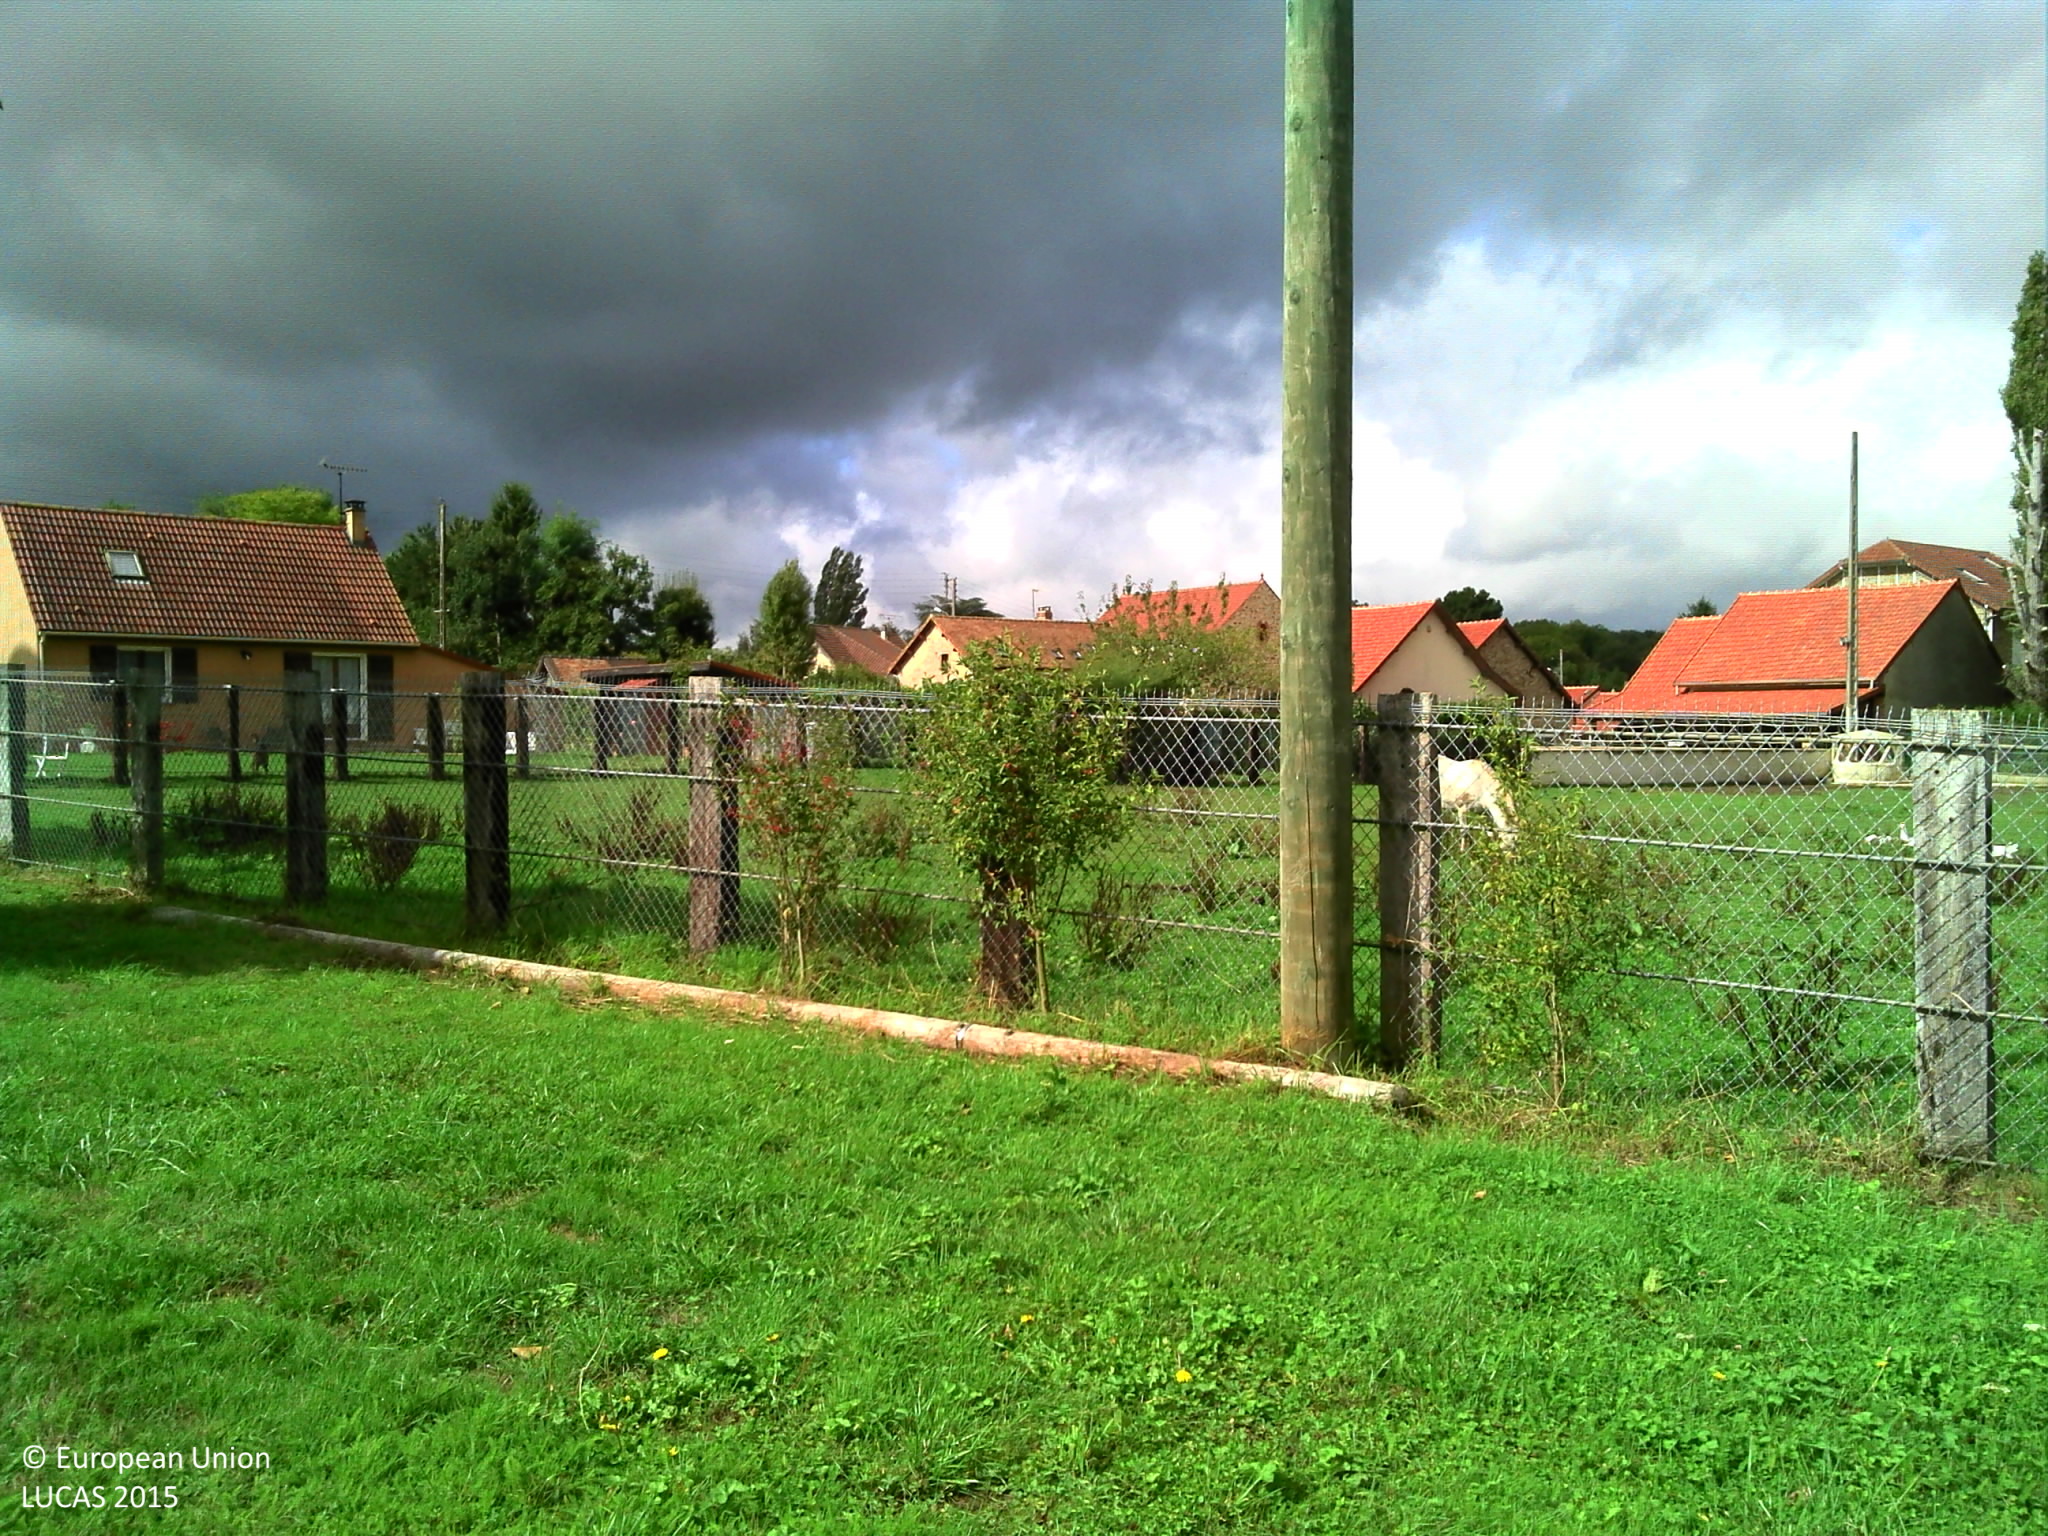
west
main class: Grassland
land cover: Grassland without tree/shrub cover
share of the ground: > 75 %
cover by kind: herbaceous plants 100 %
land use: Amenities, museums, leisure
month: September
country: FR
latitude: 48.4704
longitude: 2.9990
